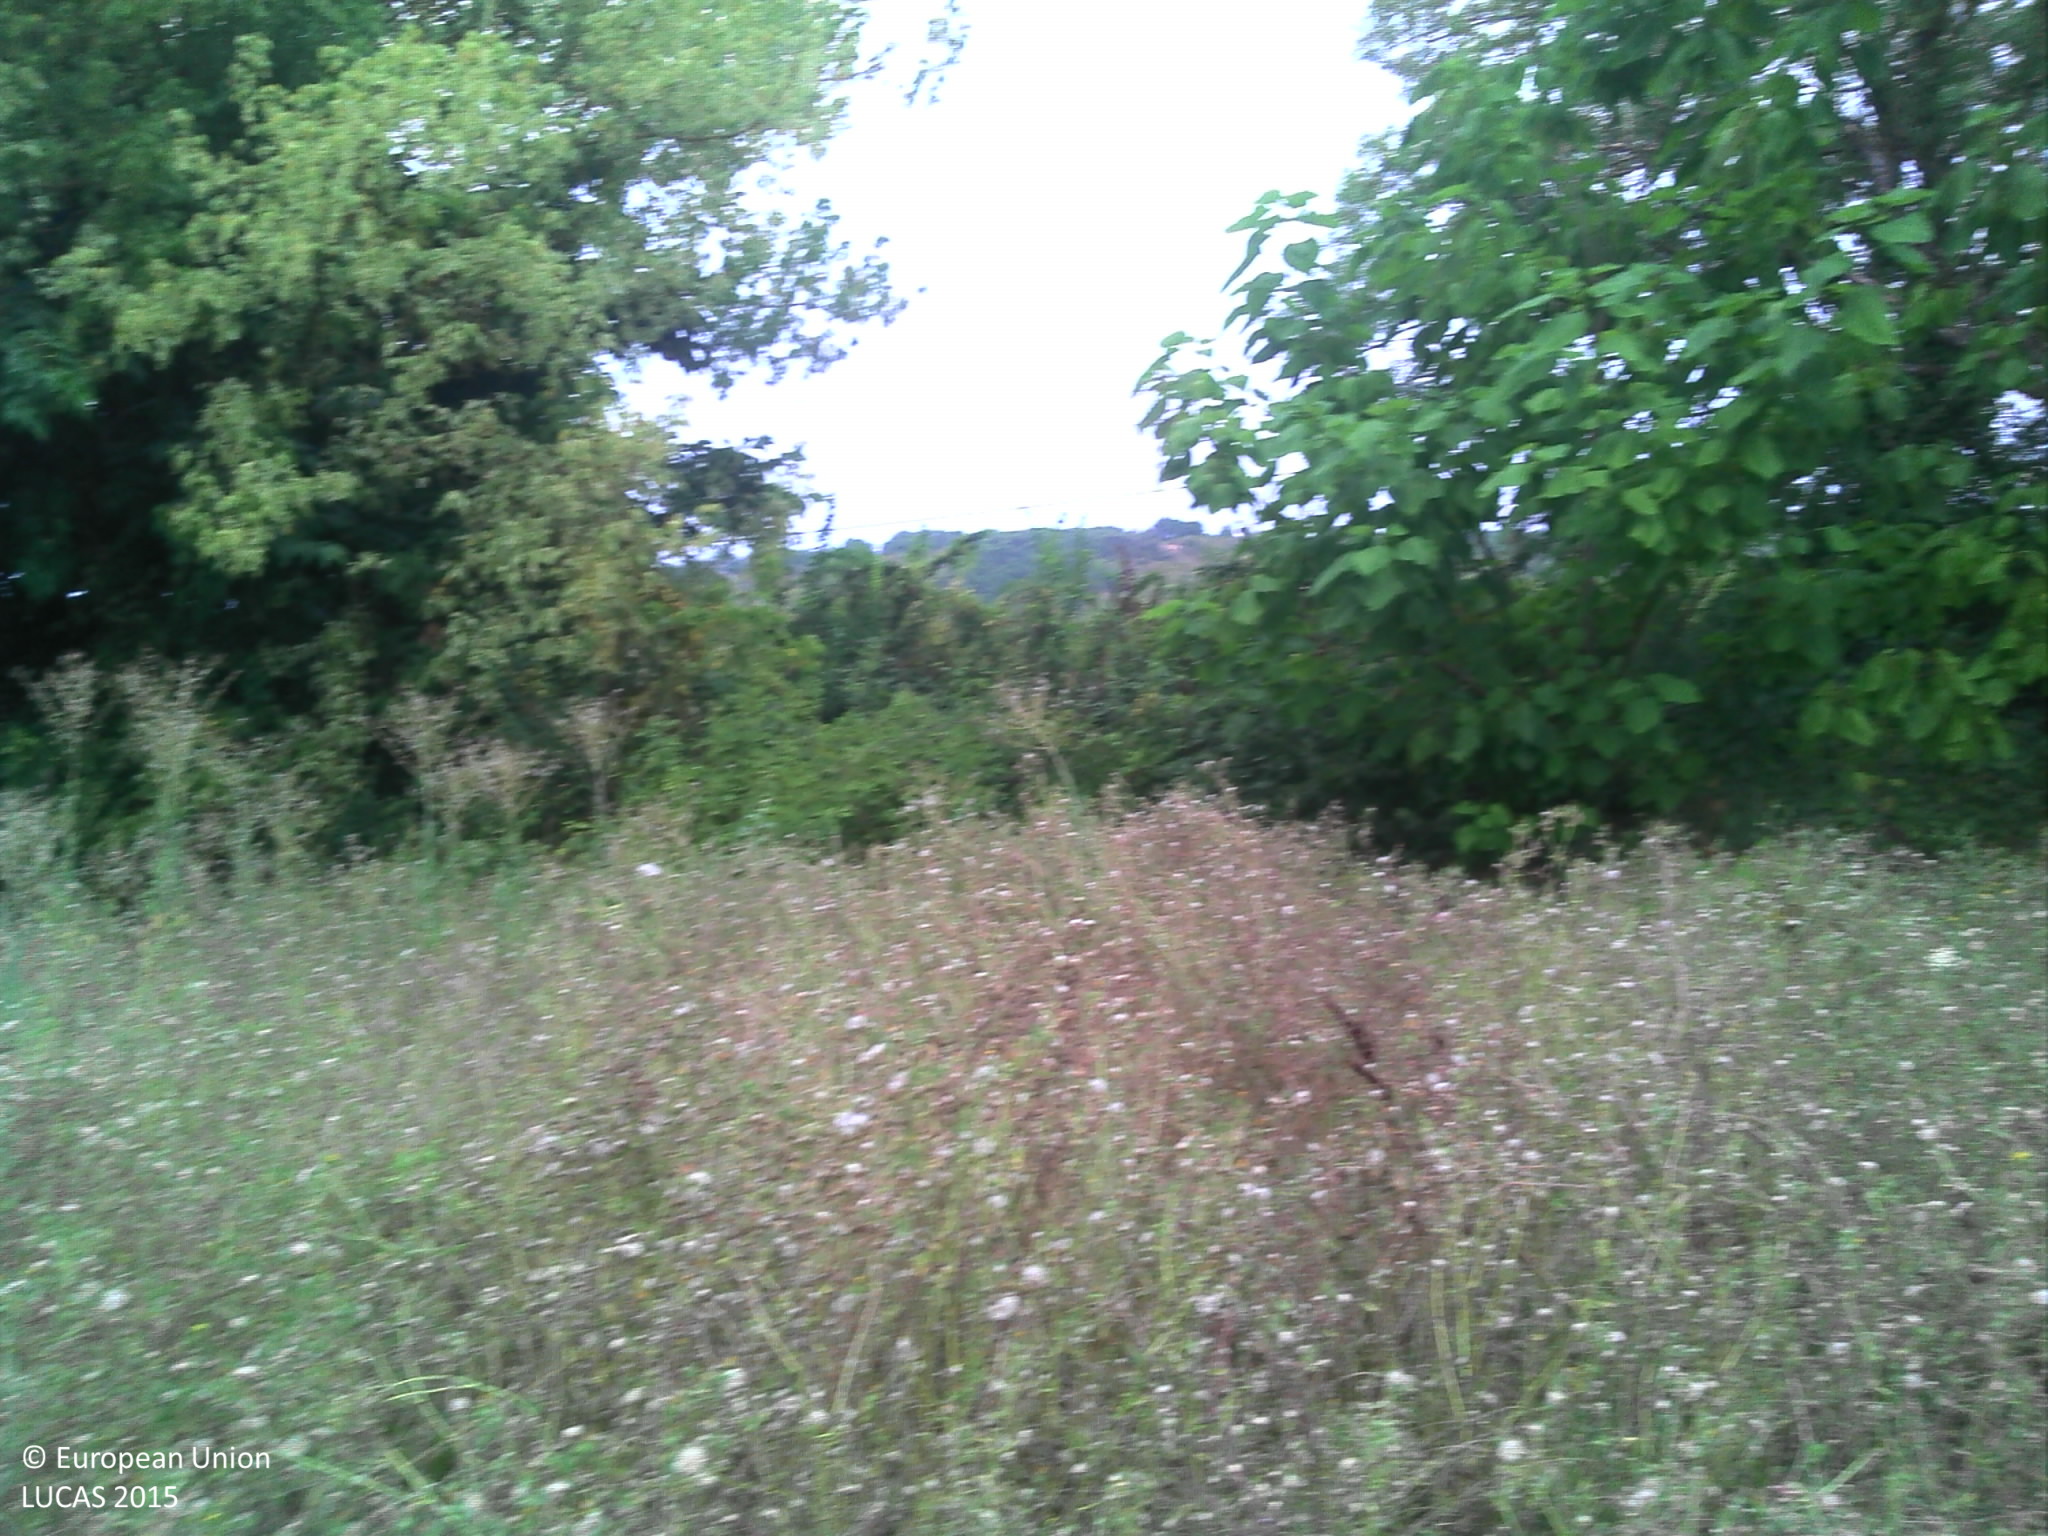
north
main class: Grassland
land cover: Spontaneously vegetated surfaces
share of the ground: > 75 %
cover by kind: herbaceous plants 100 %
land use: Fallow land
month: August
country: FR
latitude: 43.9359
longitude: 1.3674
